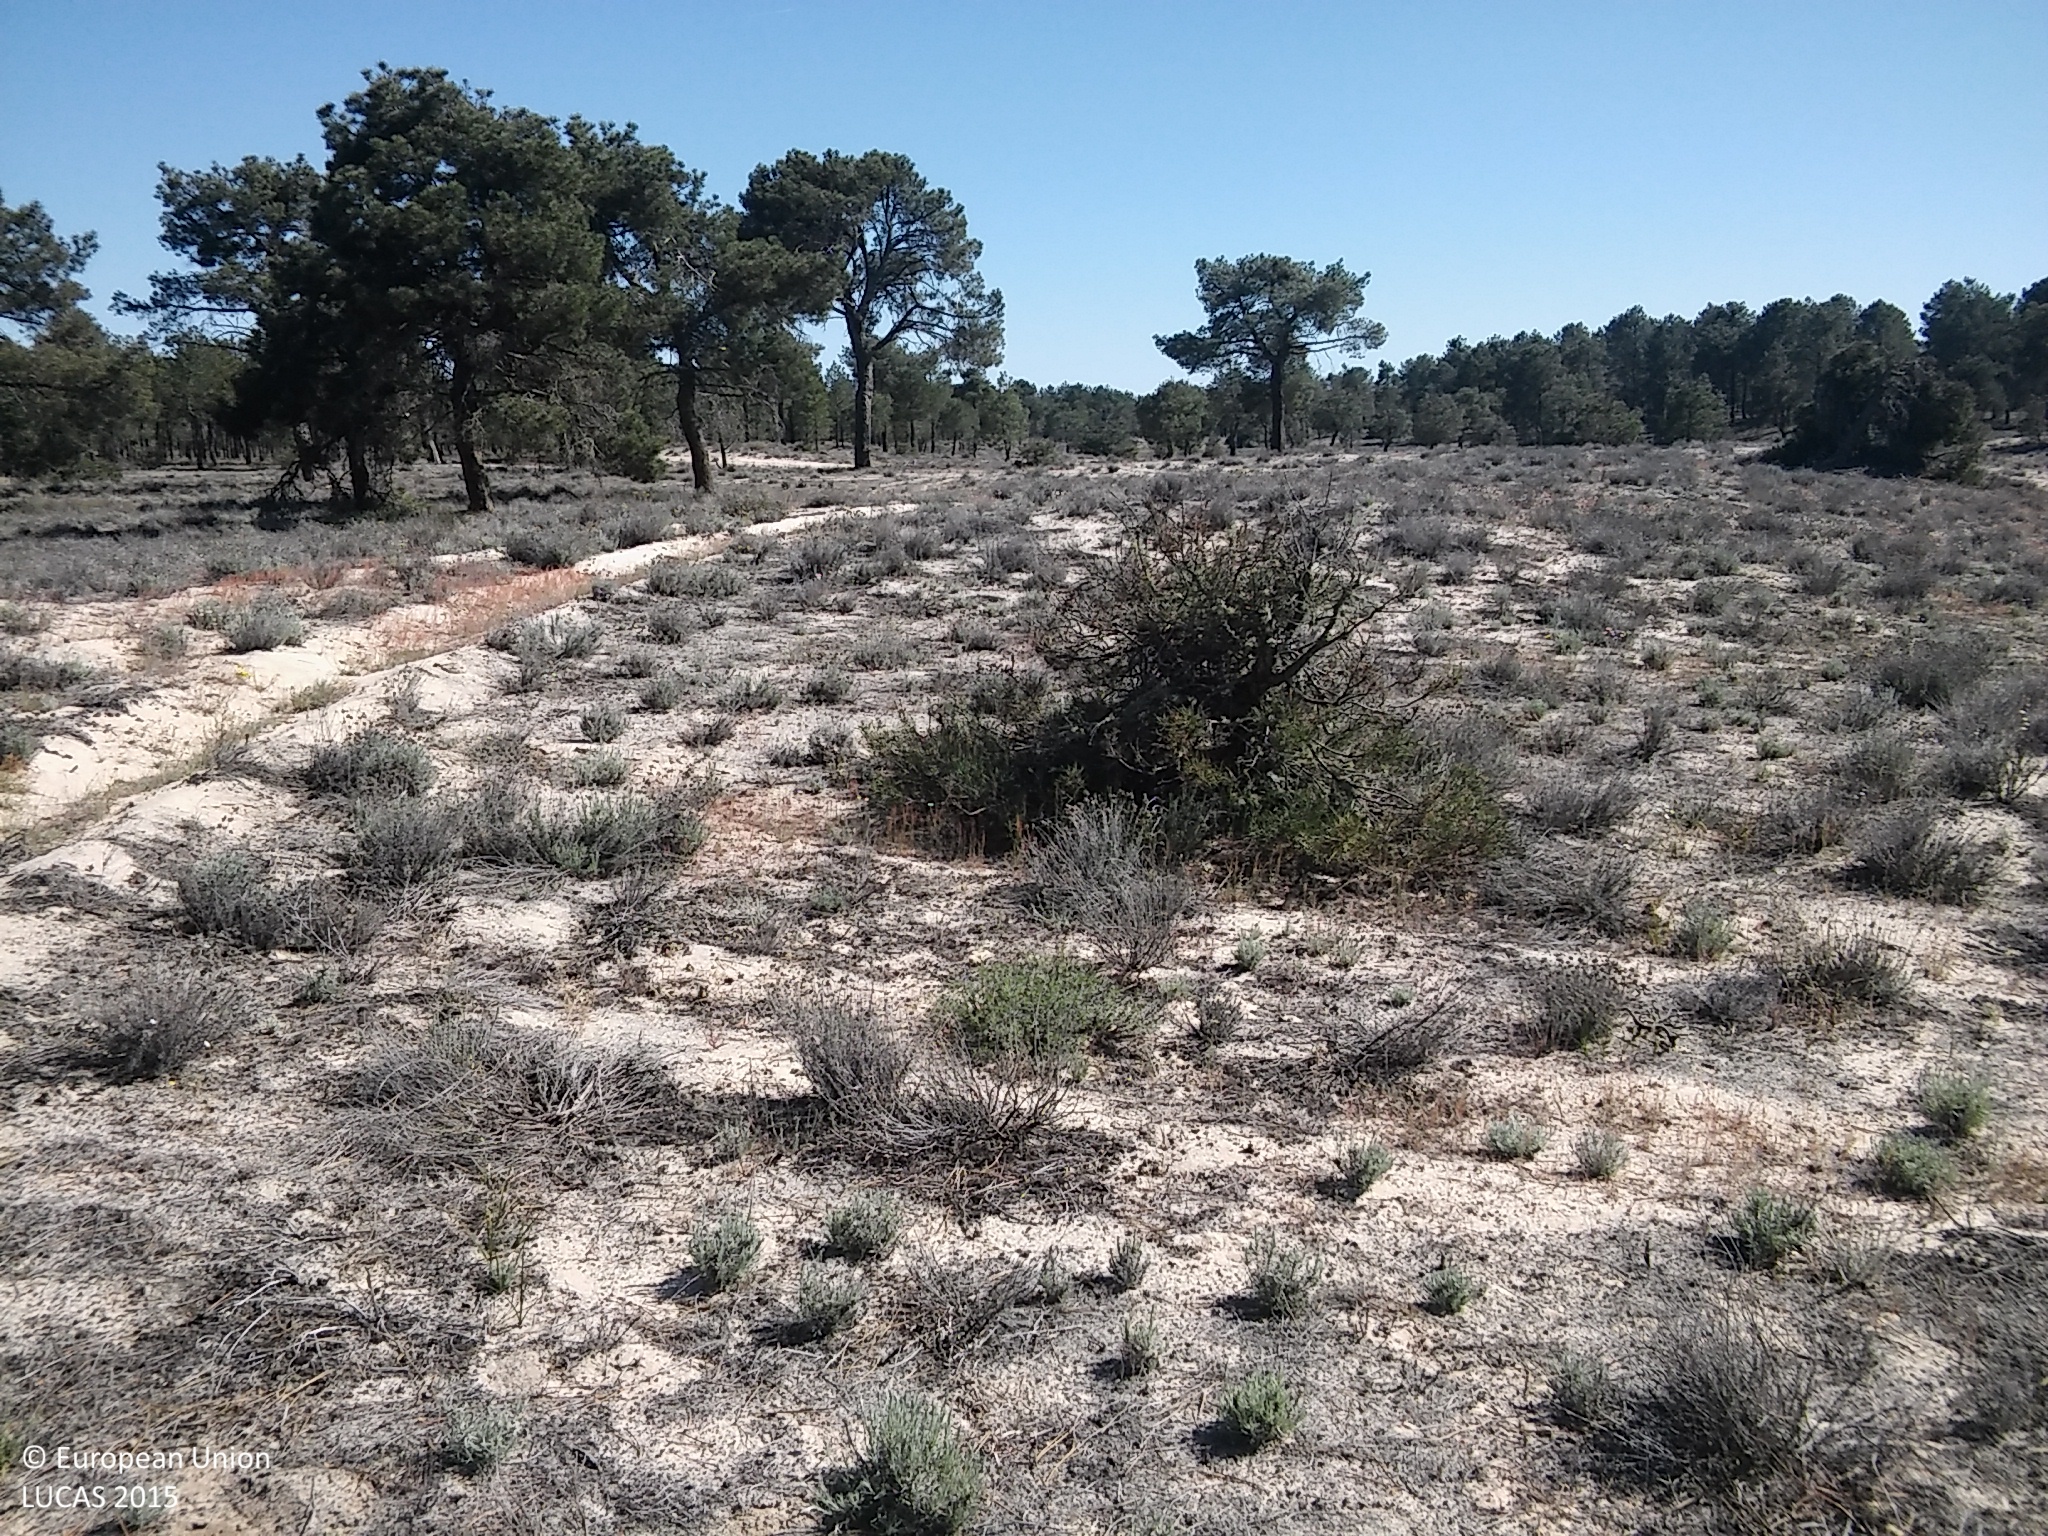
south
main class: Shrubland
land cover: Shrubland with sparse tree cover
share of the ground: 10 - 25 %
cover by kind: unconsolidated bare surface 80 %, shrubs 10 %, coniferous forest trees 5 %, herbaceous plants 5 %
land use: Forestry
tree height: > 5 m
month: May
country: ES
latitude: 41.3610
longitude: -4.0283
